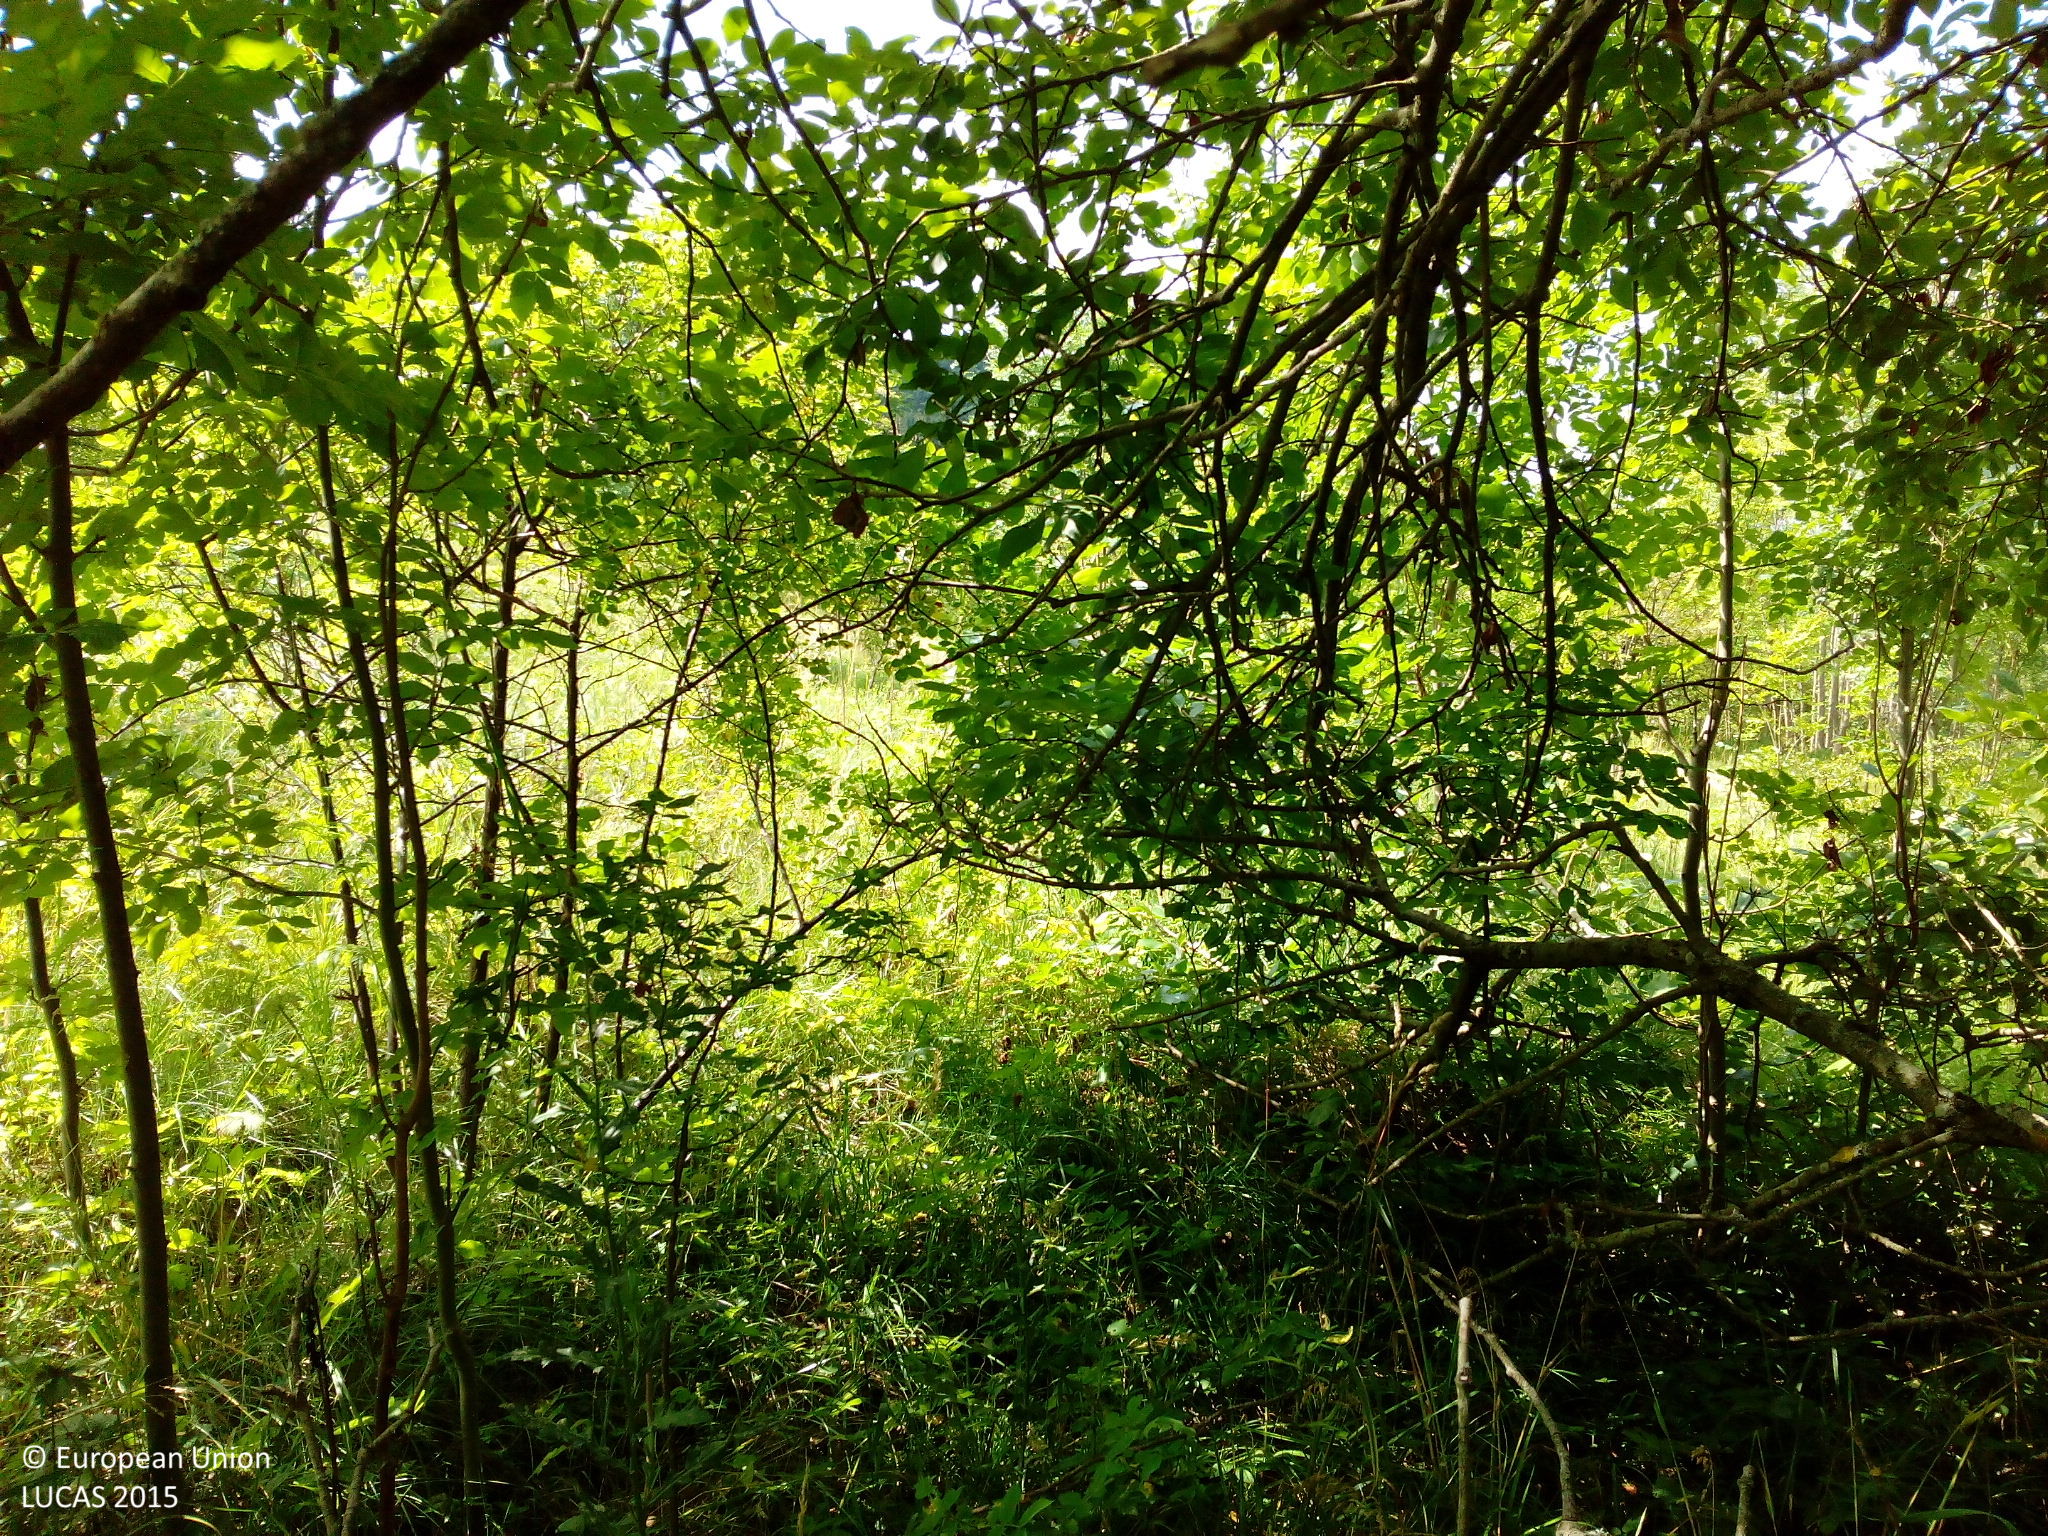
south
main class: Woodland
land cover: Broadleaved woodland
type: mesophytic deciduous forest
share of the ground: > 75 %
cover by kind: broadleaved forest trees 90 %, herbaceous plants 10 %
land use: Forestry
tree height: > 5 m
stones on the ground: < 10 %
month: July
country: DE
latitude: 50.5079
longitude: 9.9295
